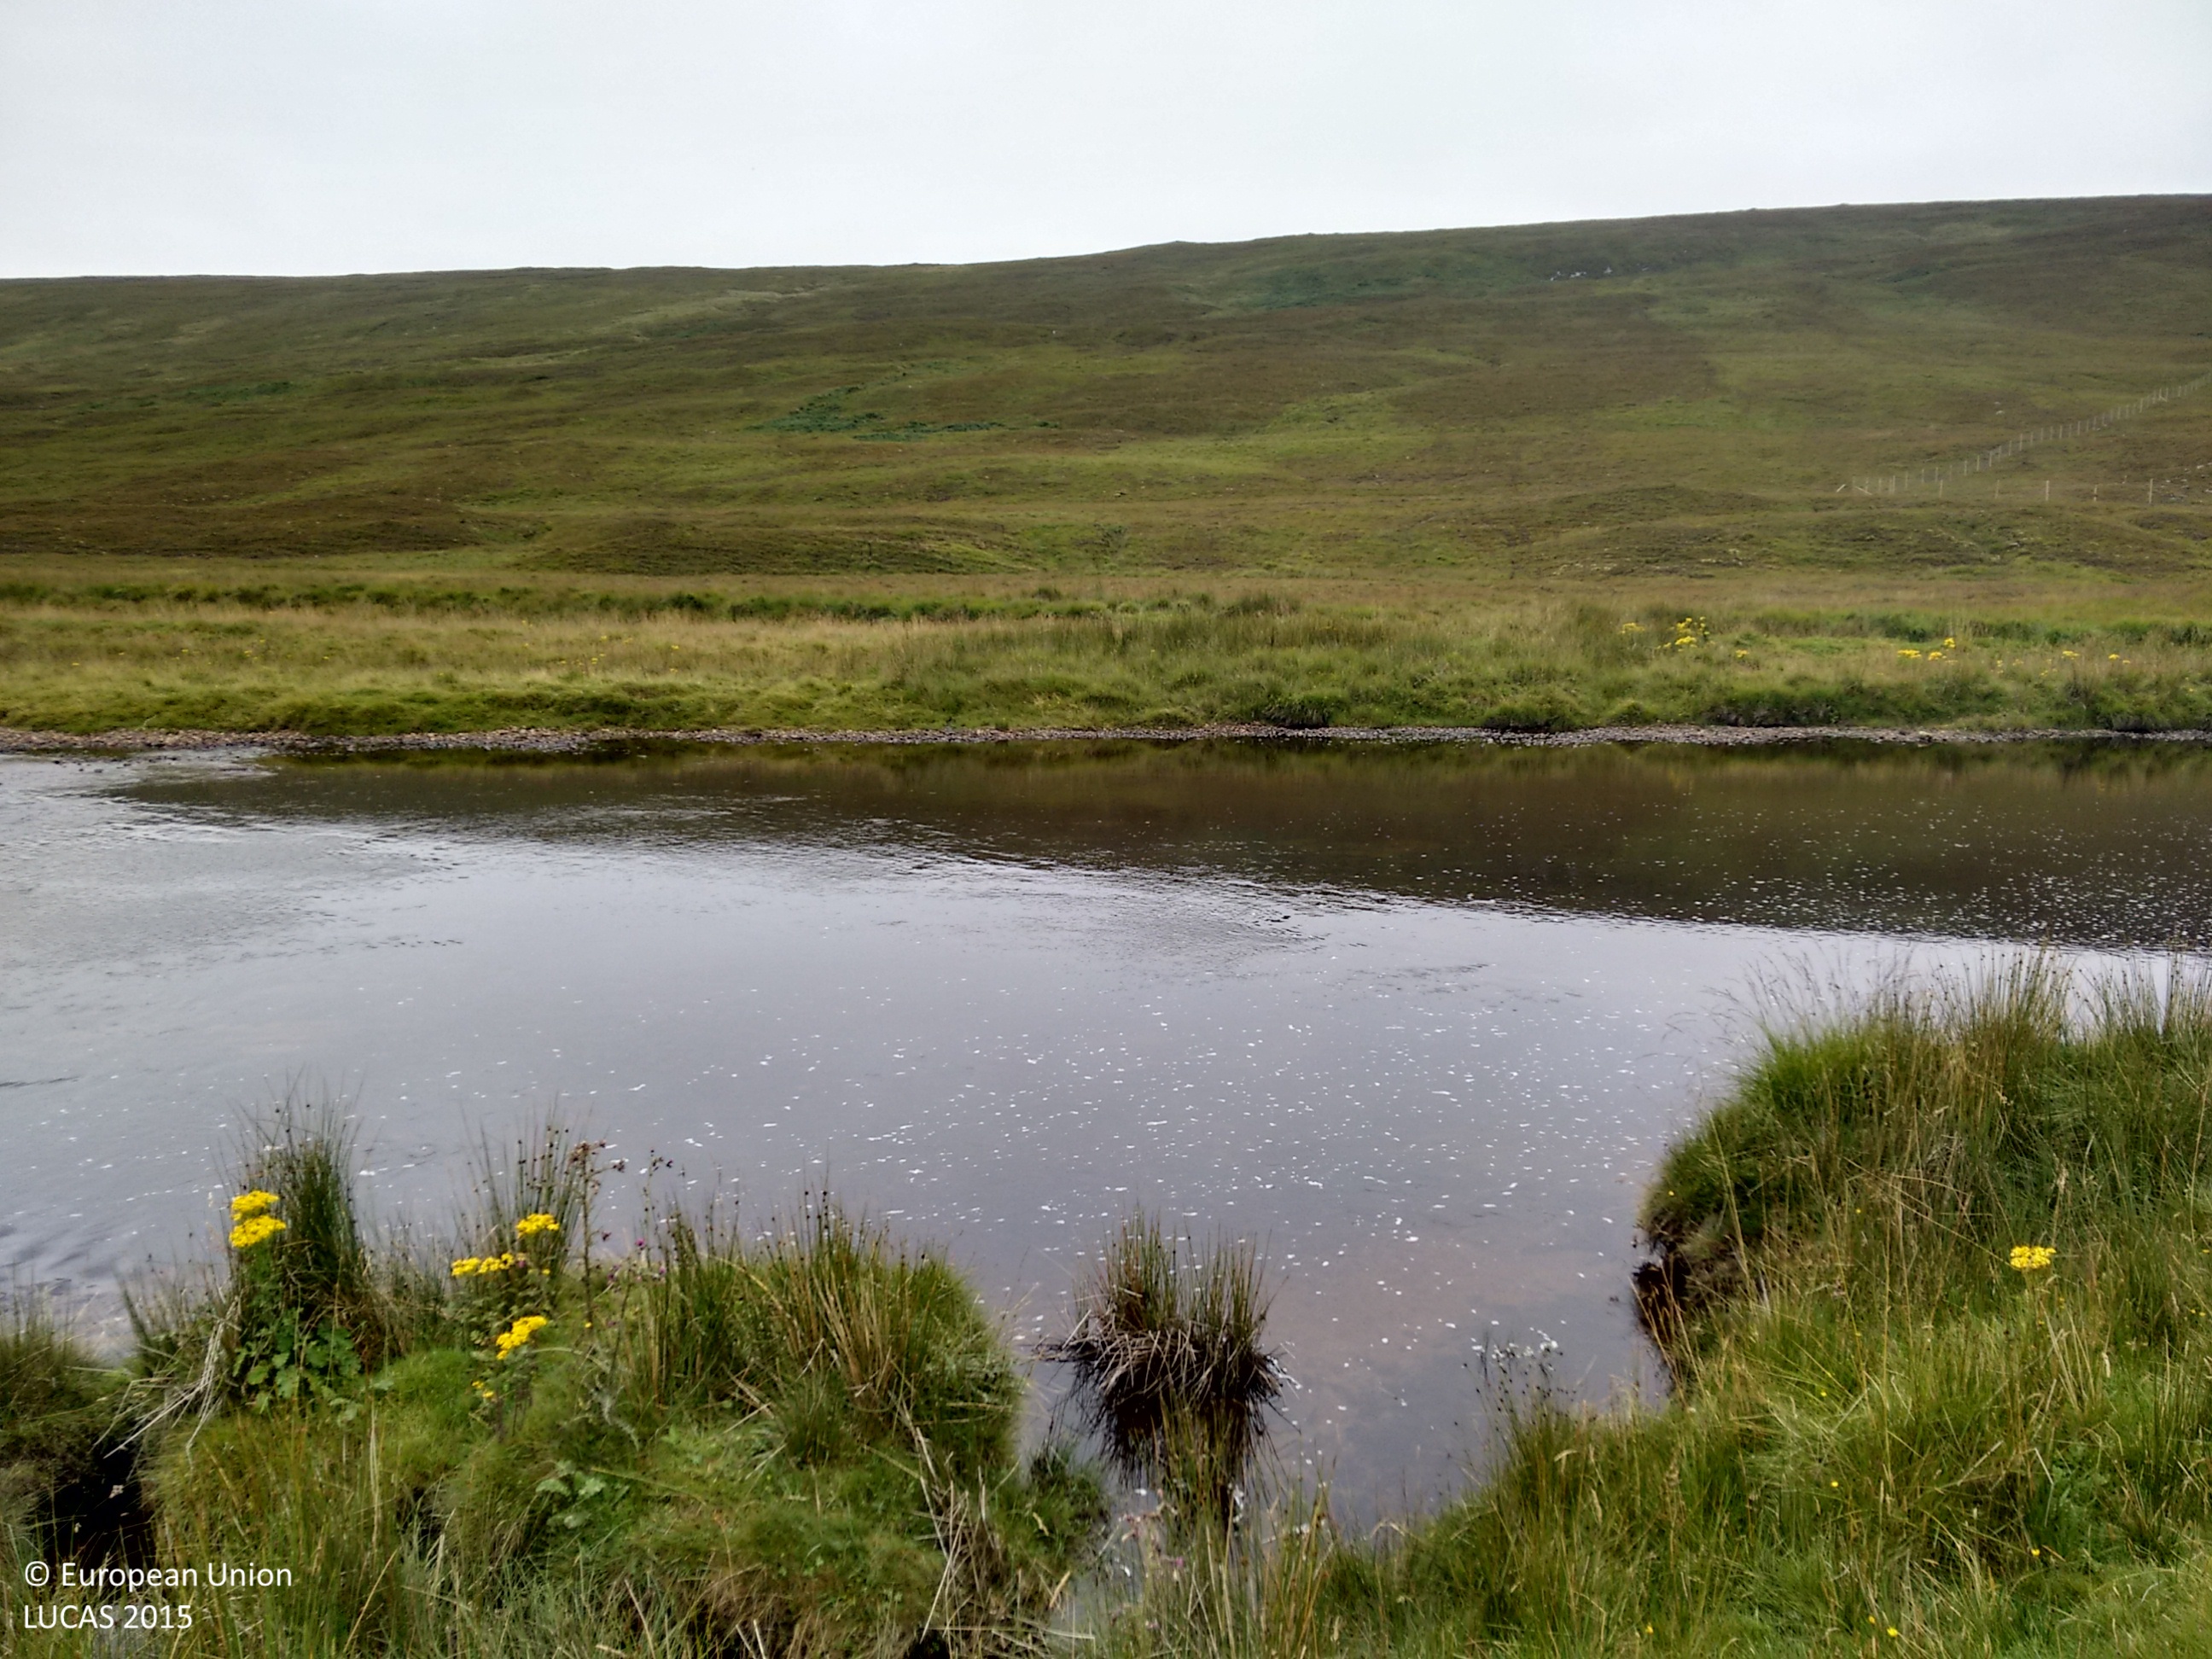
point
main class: Shrubland
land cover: Shrubland without tree cover
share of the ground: > 75 %
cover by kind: shrubs 75 %, herbaceous plants 25 %
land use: Agriculture (excluding fallow land and kitchen gardens)
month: September
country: GB
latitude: 58.0977
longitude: -4.7341
